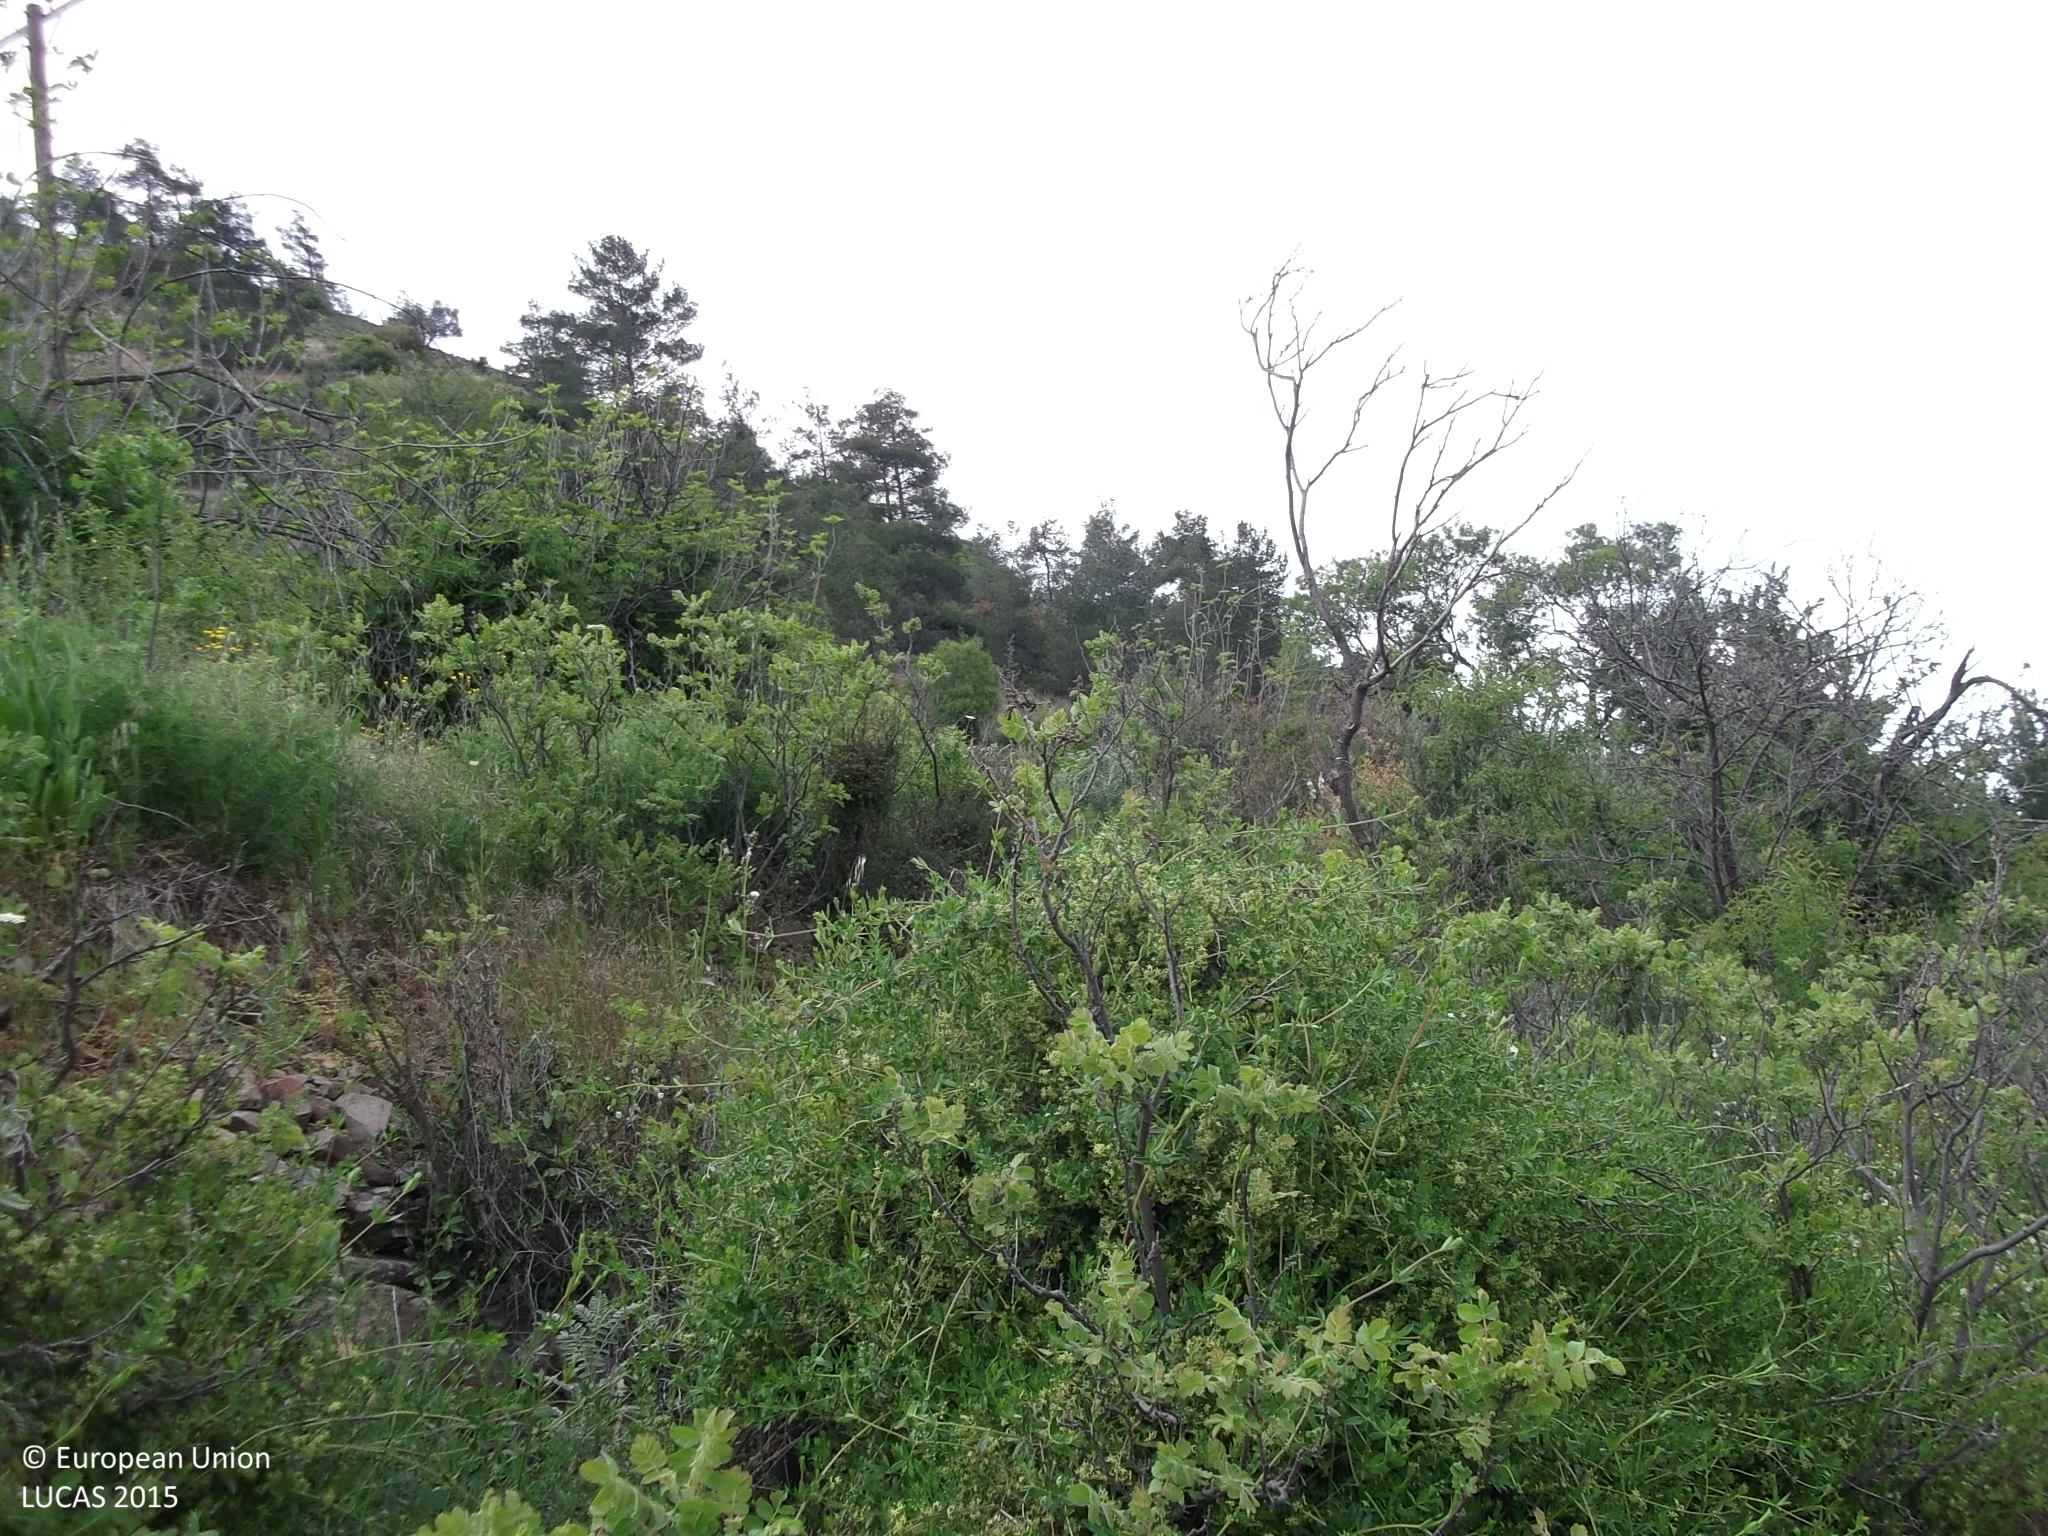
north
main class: Woodland
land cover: Pine dominated coniferous woodland
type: coniferous forest of the mediterranean region
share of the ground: 10 - 25 %
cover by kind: shrubs 65 %, unconsolidated bare surface 20 %, coniferous forest trees 15 %
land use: Semi-natural and natural areas not in use
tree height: > 5 m
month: April
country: CY
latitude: 34.9460
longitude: 33.1387
